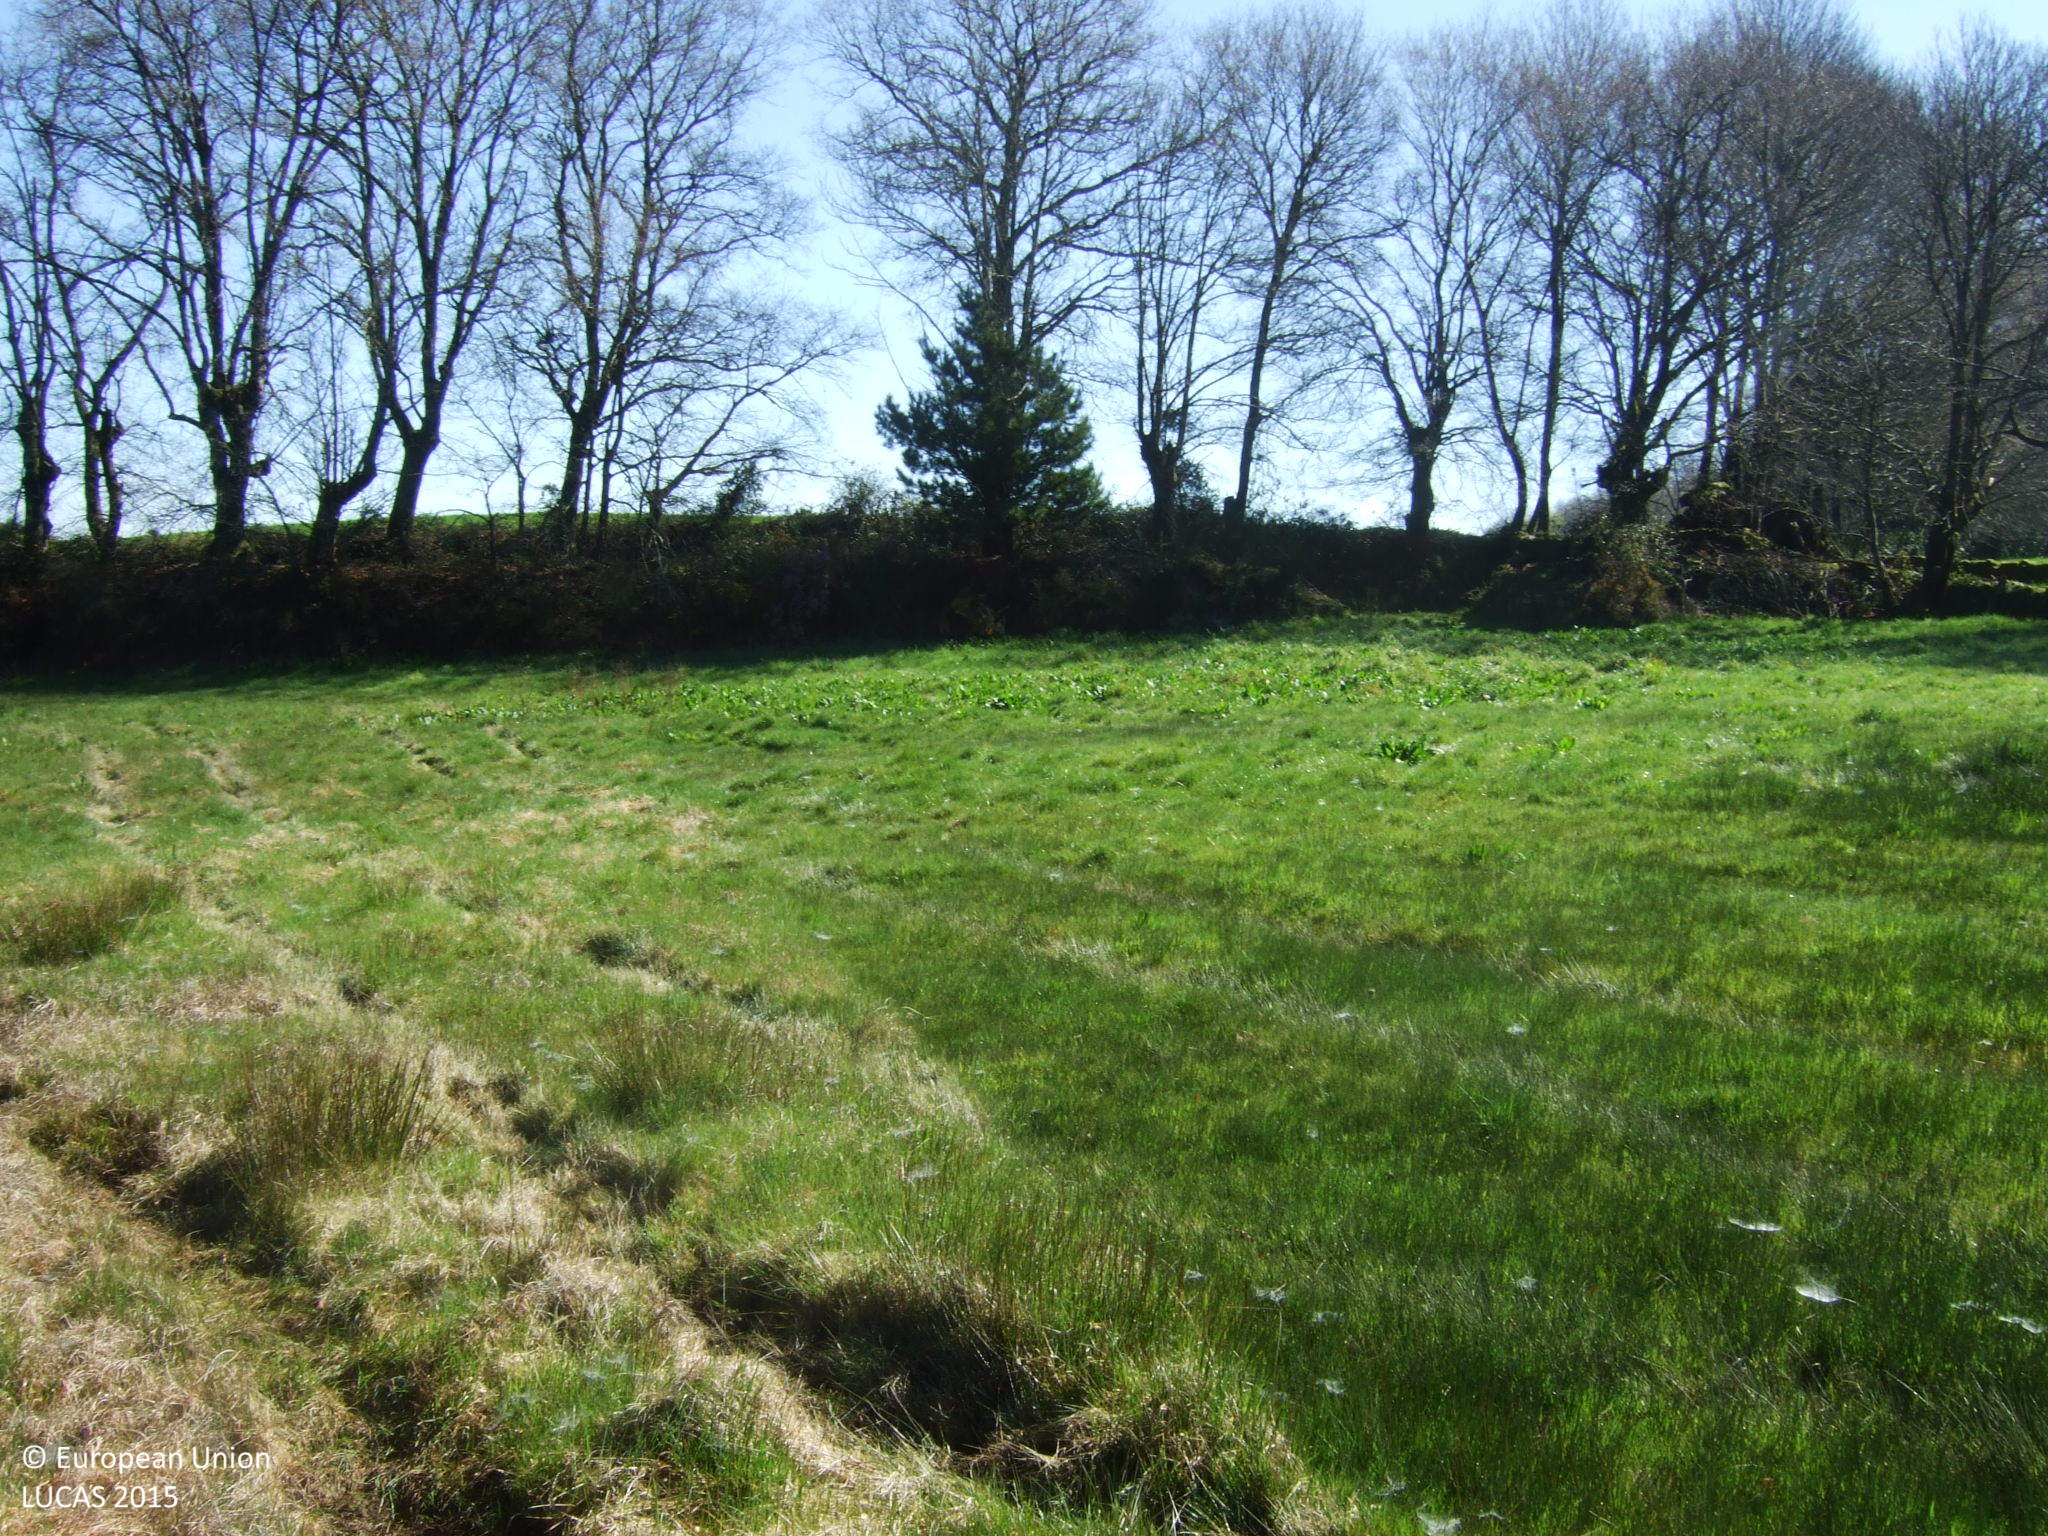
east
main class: Grassland
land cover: Grassland without tree/shrub cover
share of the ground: > 75 %
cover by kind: herbaceous plants 100 %
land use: Agriculture (excluding fallow land and kitchen gardens)
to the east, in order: Grassland without tree/shrub cover; Groves; Tracks; Groves; Temporary grasslands; Broadleaved woodland
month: April
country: ES
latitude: 42.6965
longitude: -7.8422
